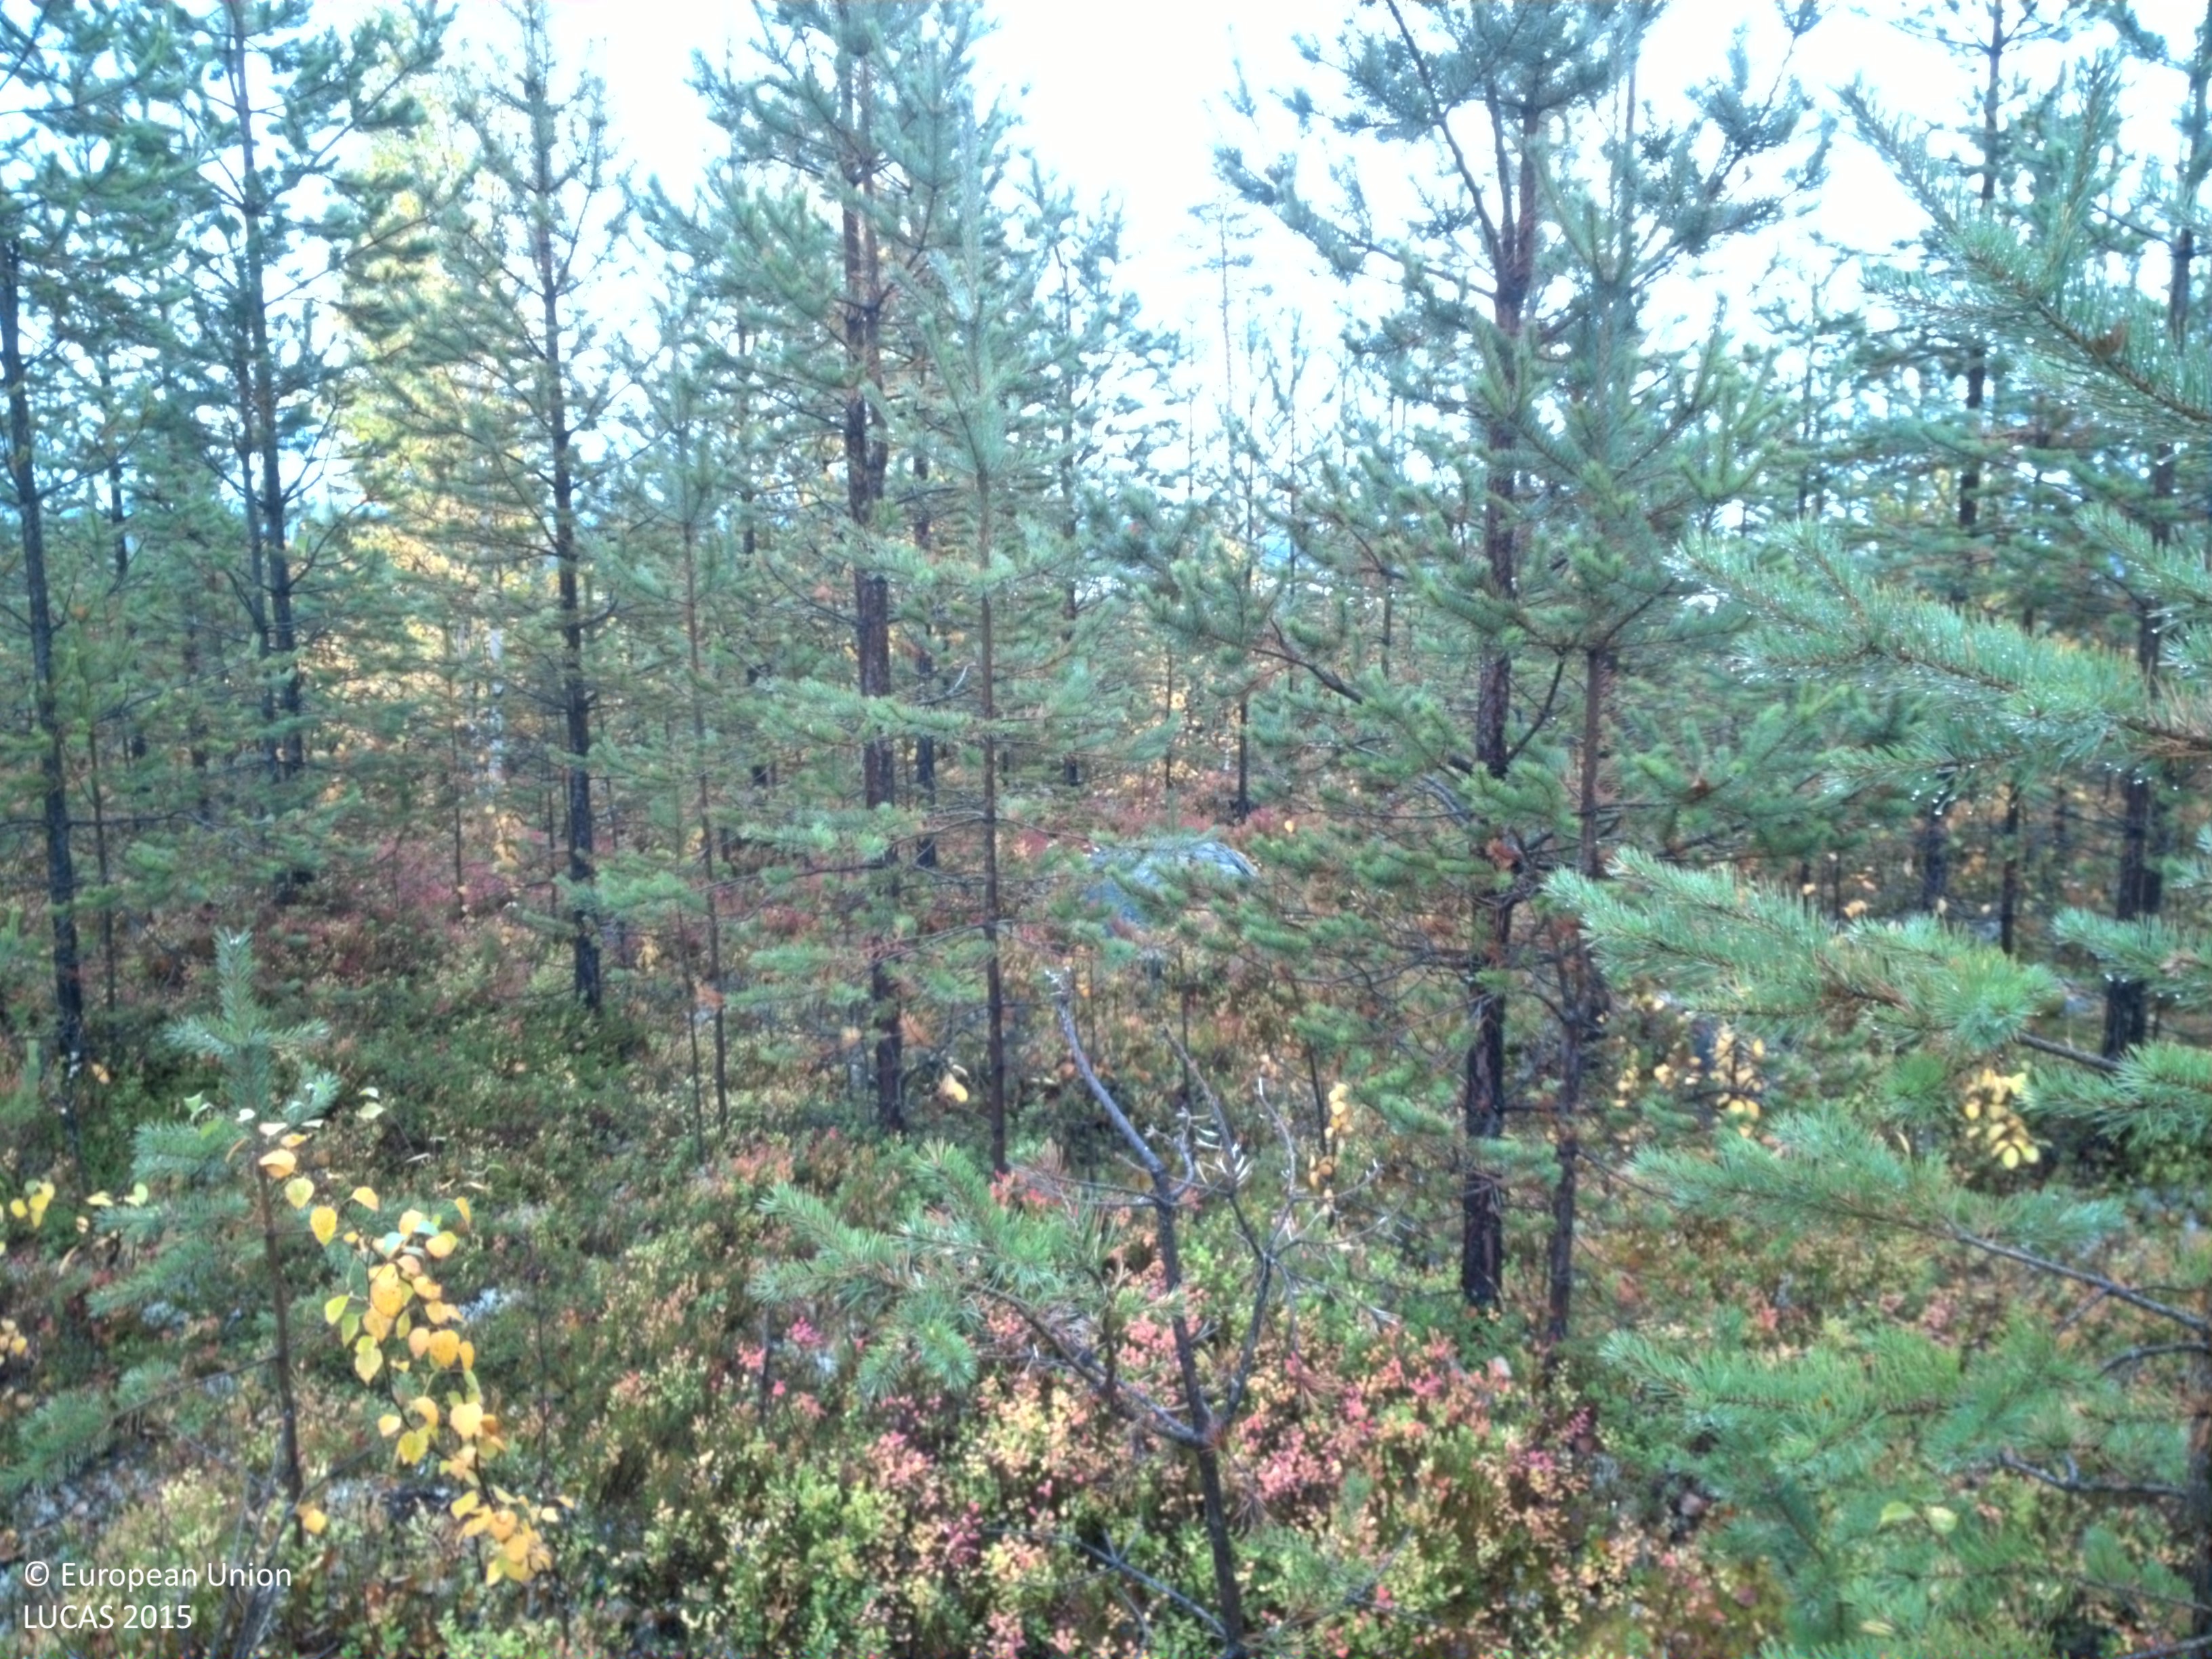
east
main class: Woodland
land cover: Pine dominated coniferous woodland
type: boreal forest
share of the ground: 25 - 50 %
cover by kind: shrubs 40 %, lichens and mosses 30 %, coniferous forest trees 20 %, broadleaved forest trees 5 %, unconsolidated bare surface 5 %
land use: Forestry
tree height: > 5 m
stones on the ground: < 10 %
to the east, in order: Pine dominated coniferous woodland; Tracks; Shrubland with sparse tree cover; Tracks; Shrubland with sparse tree cover; Tracks; Shrubland with sparse tree cover; Pine dominated coniferous woodland; Pine dominated mixed woodland; Pine dominated coniferous woodland
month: September
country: SE
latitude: 65.0934
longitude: 17.4751
